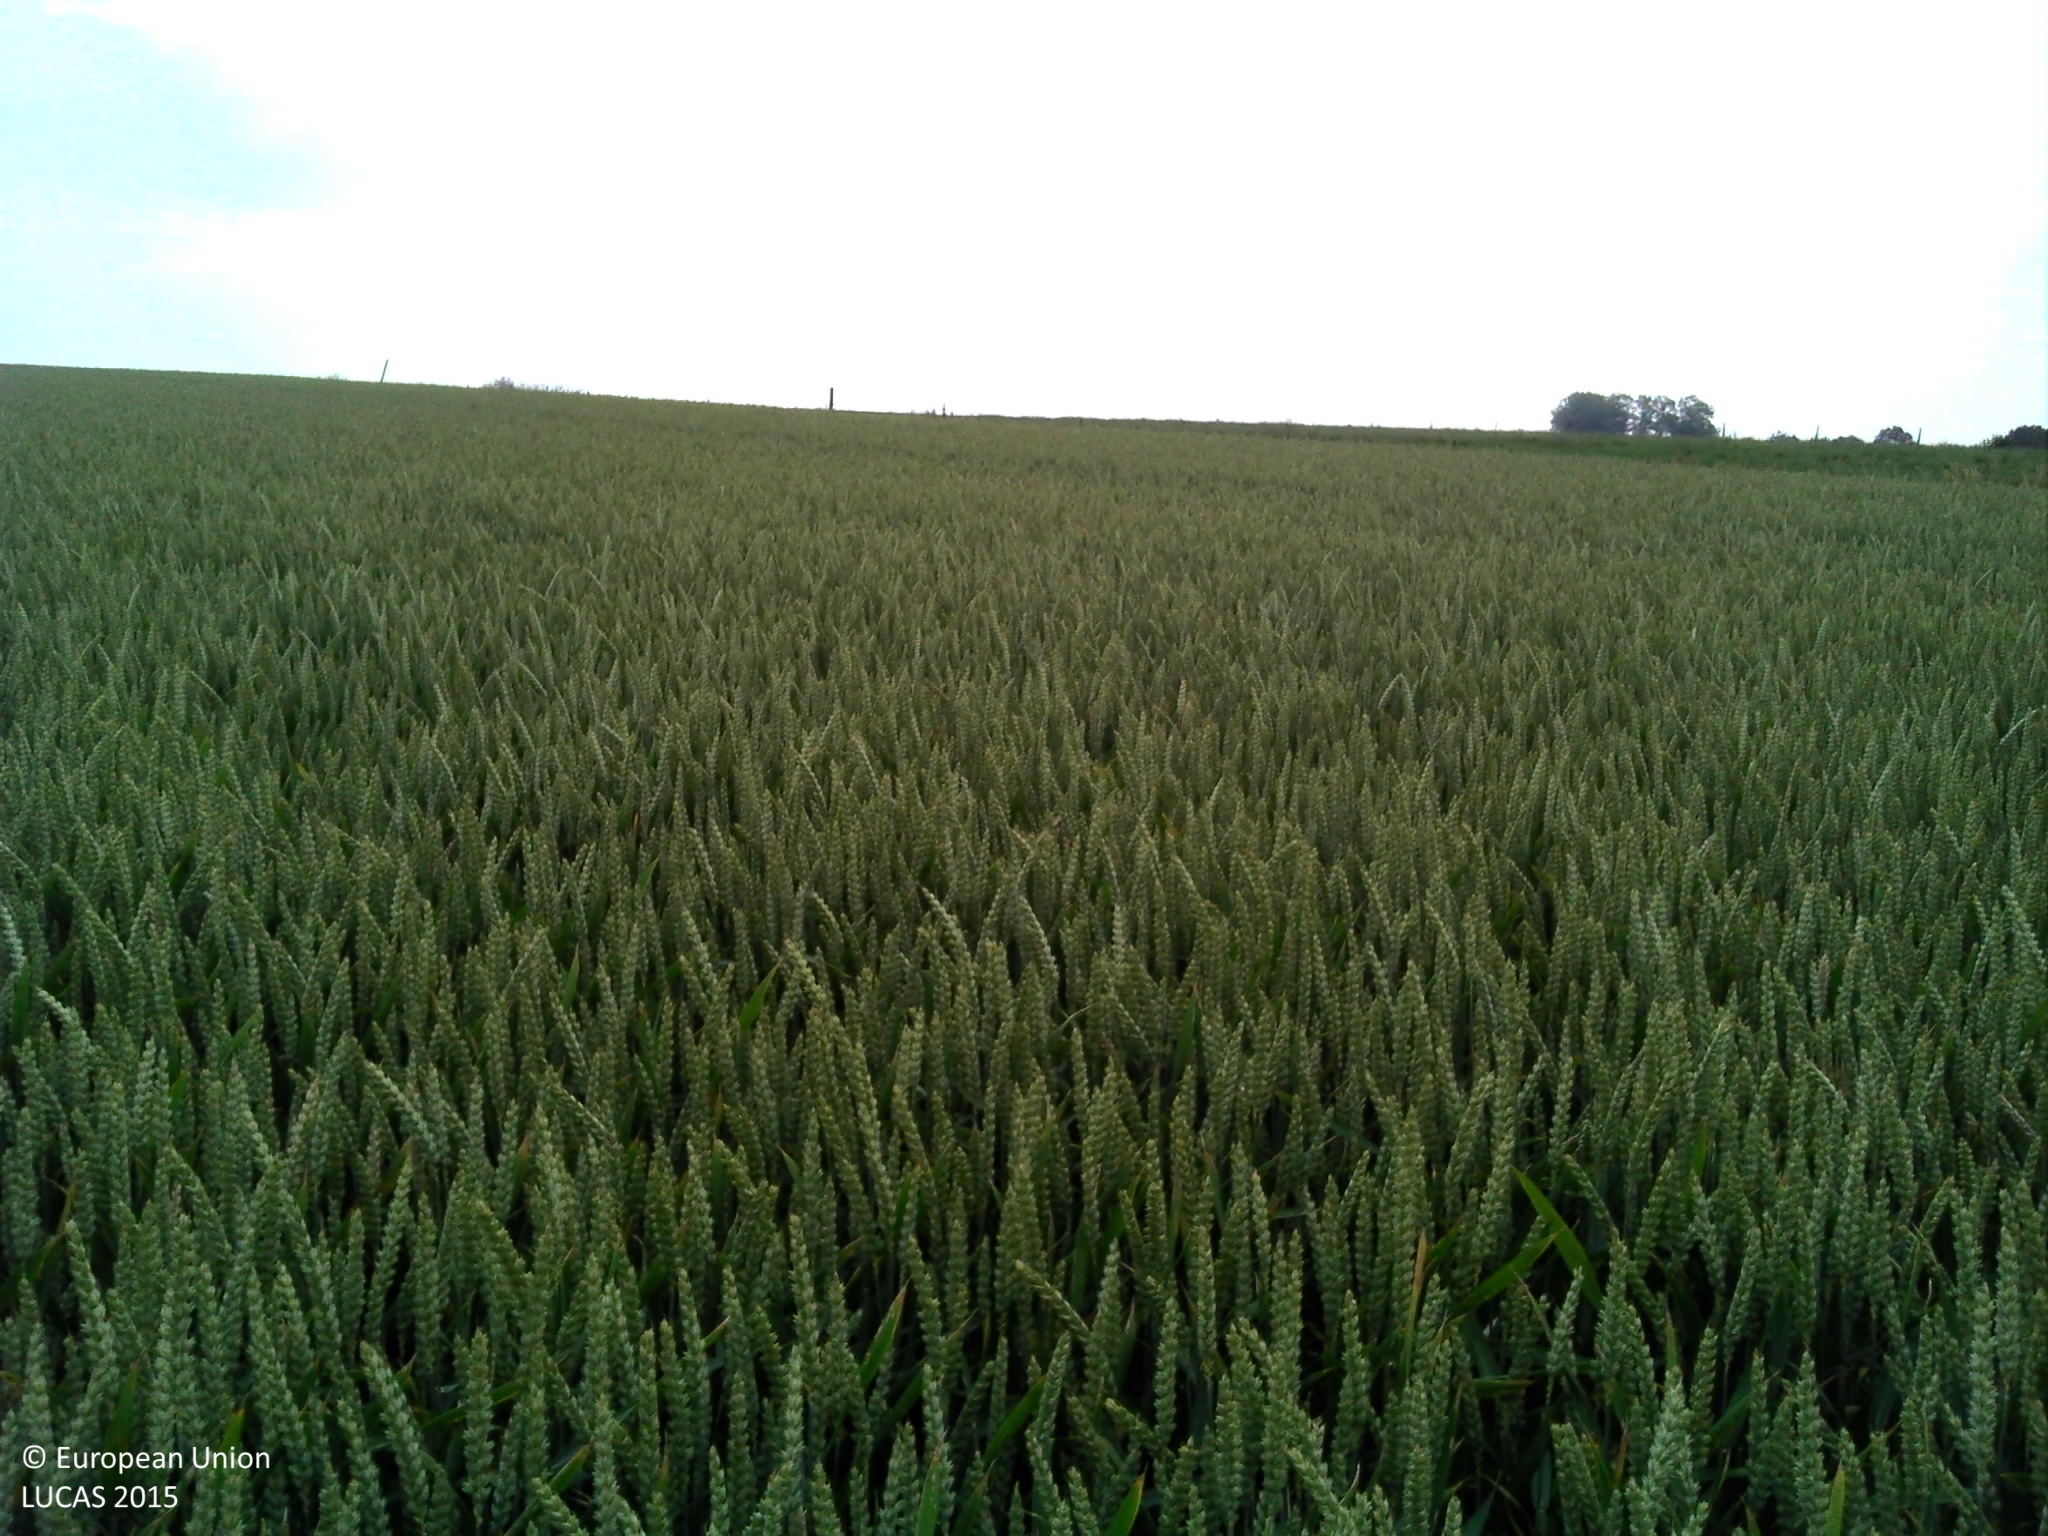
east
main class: Cropland
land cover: Common wheat
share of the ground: > 75 %
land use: Agriculture (excluding fallow land and kitchen gardens)
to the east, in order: Common wheat; Fences; Grassland without tree/shrub cover; Fences; Common wheat
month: July
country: FR
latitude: 50.4547
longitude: 2.1400
